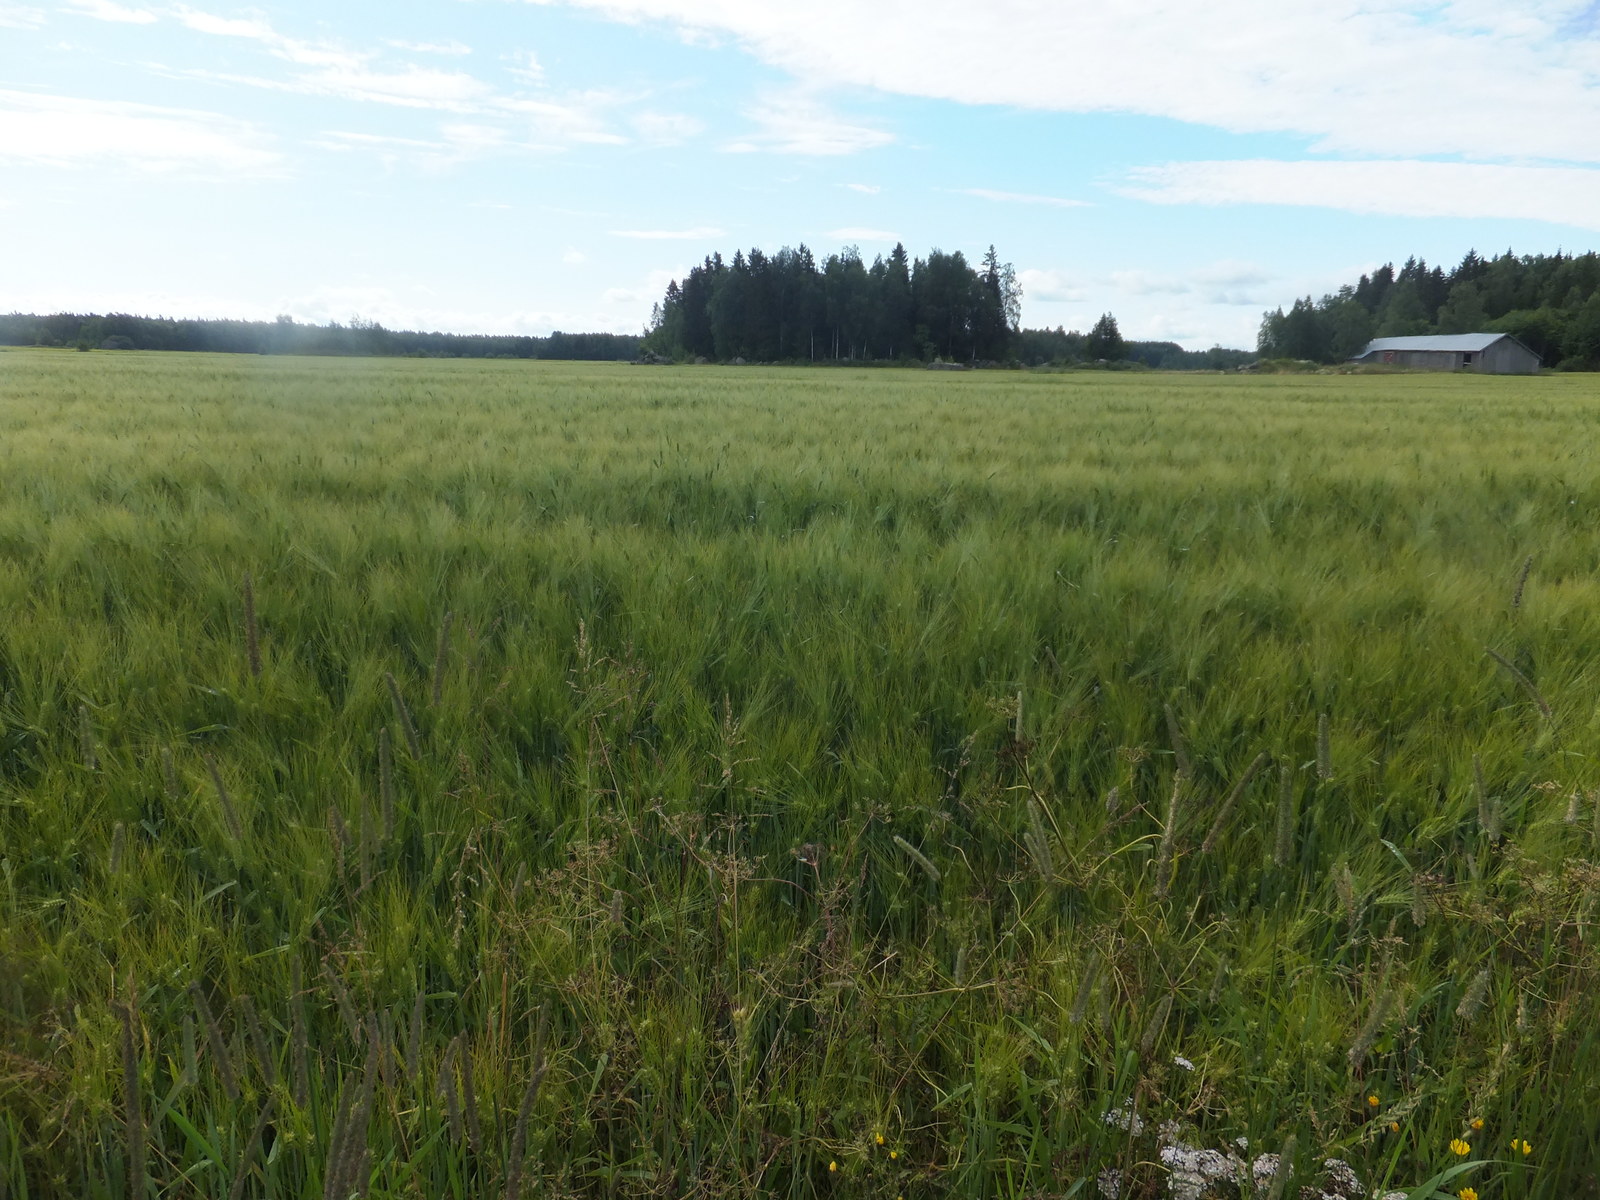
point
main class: Cropland
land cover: Barley
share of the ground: > 75 %
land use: Agriculture (excluding fallow land and kitchen gardens)
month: July
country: FI
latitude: 63.0409
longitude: 22.0466
